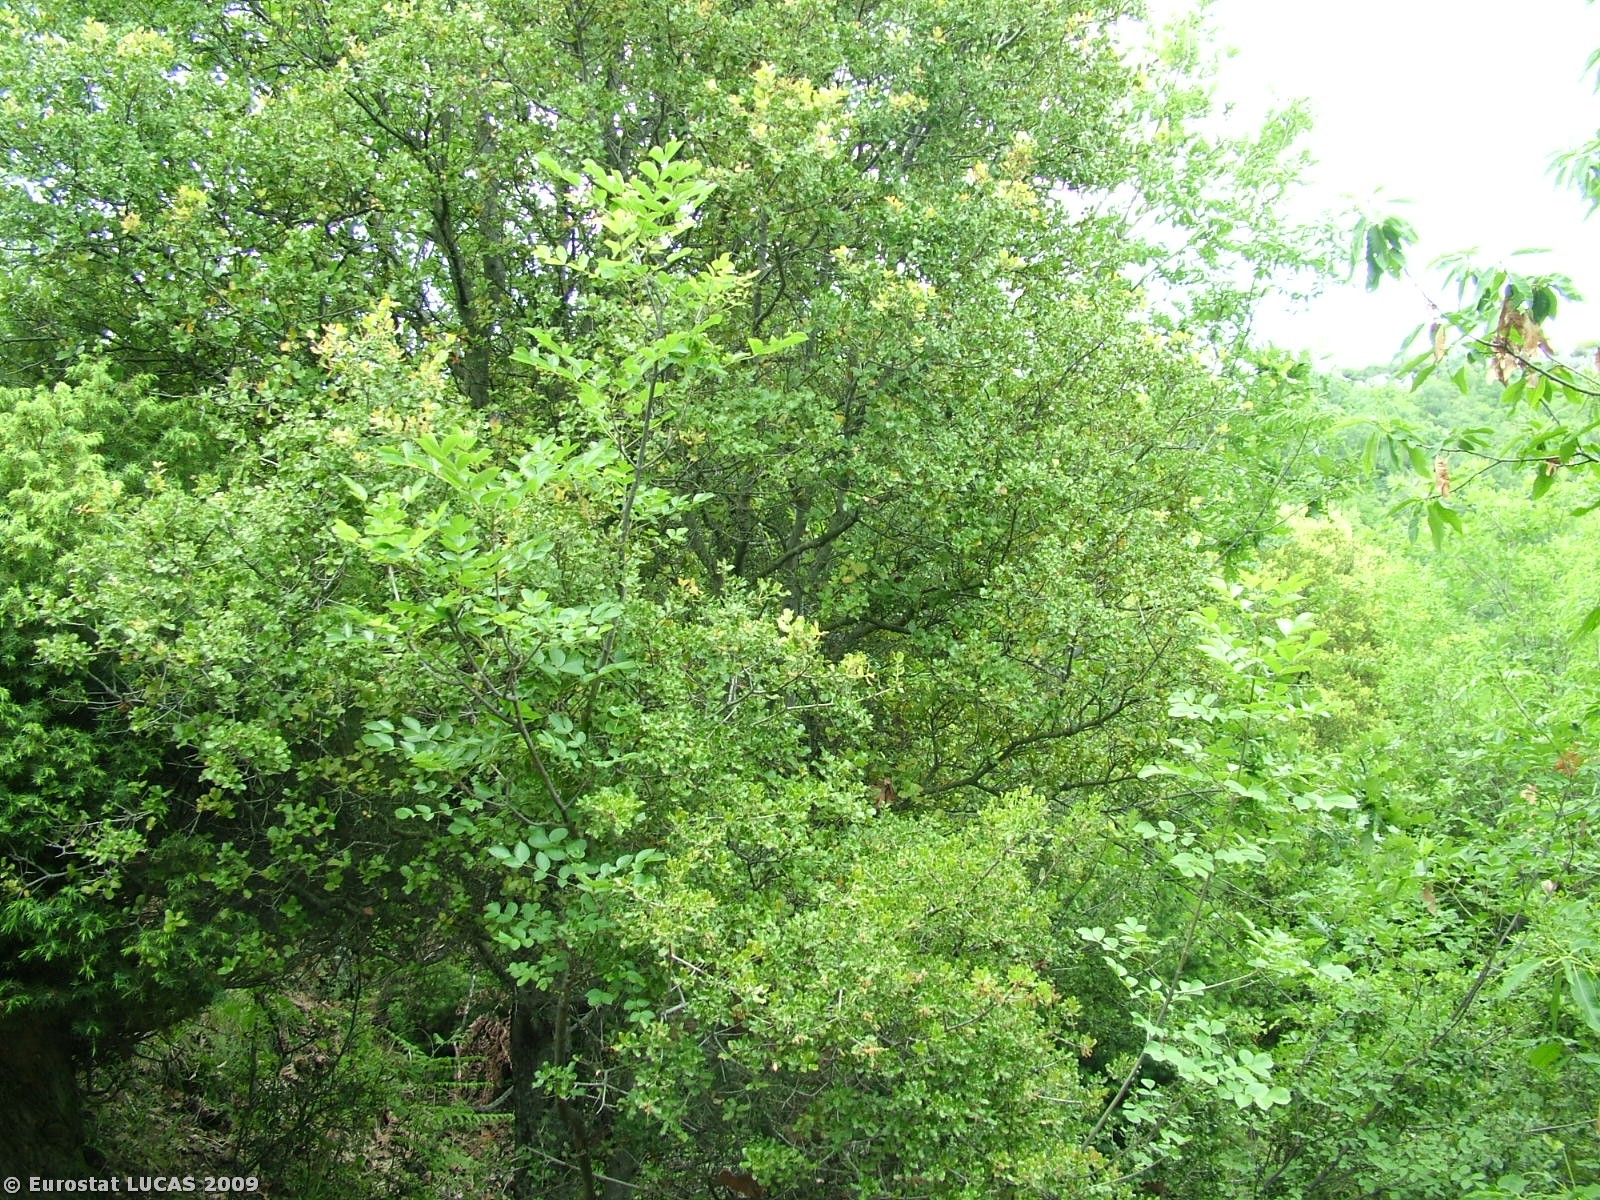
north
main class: Woodland
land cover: Broadleaved woodland
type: thermophilous deciduous forest
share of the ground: > 75 %
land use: Agriculture (excluding fallow land and kitchen gardens)
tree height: > 5 m
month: May
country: GR
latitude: 41.1129
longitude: 24.6007
